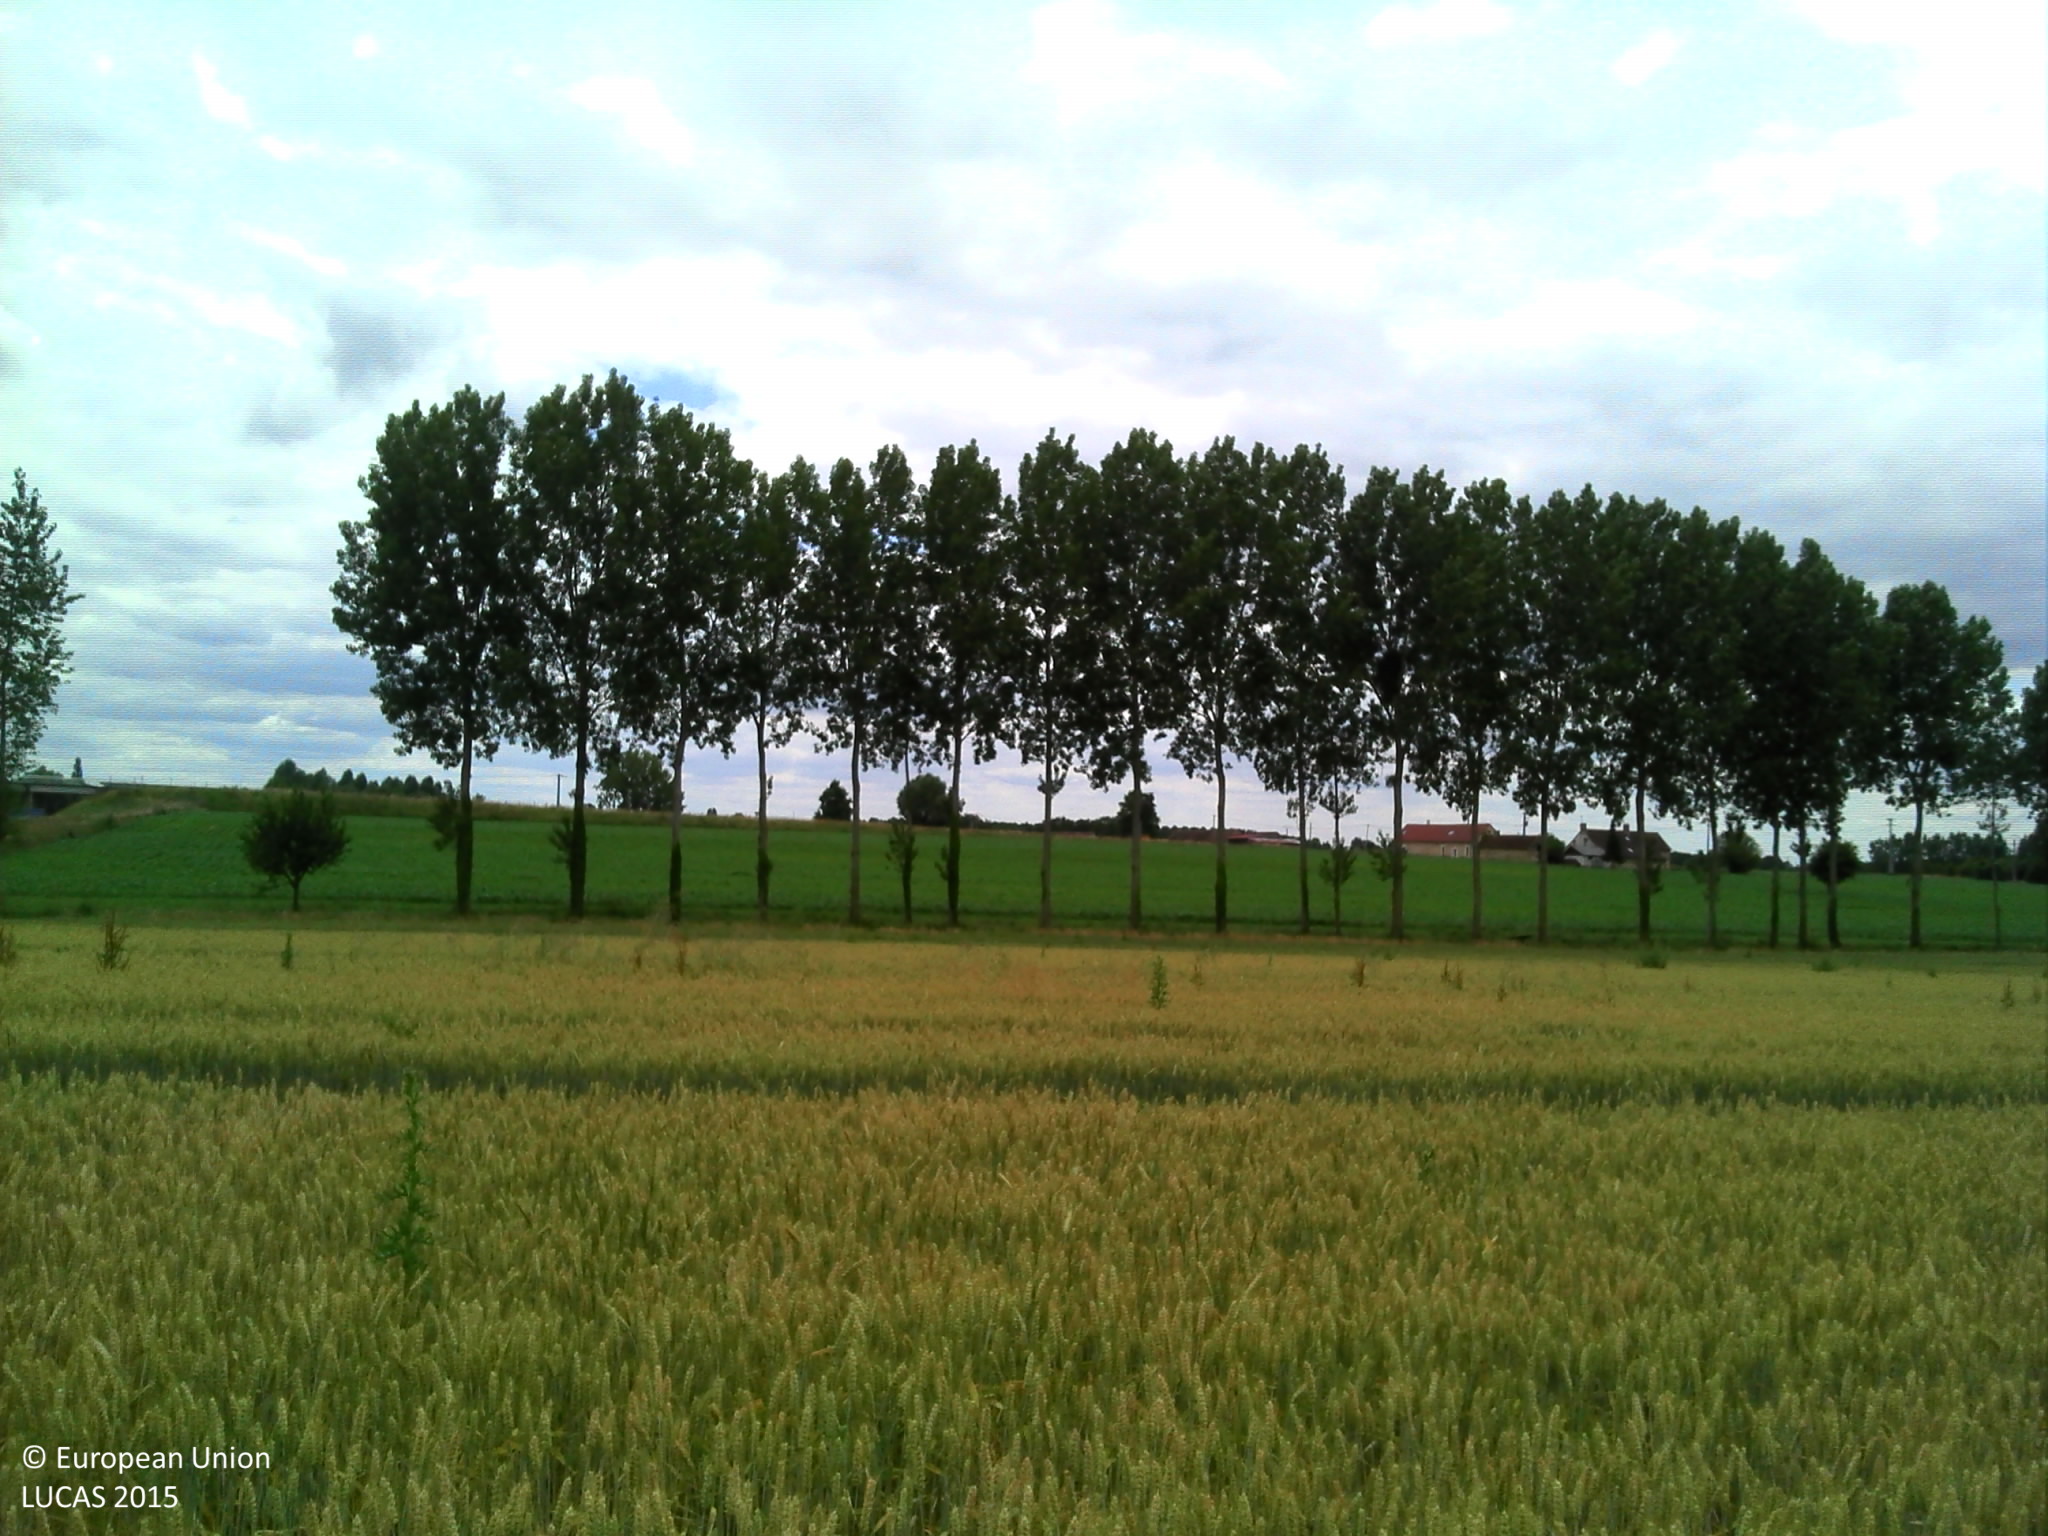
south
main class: Cropland
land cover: Common wheat
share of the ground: > 75 %
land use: Agriculture (excluding fallow land and kitchen gardens)
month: June
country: FR
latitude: 47.9039
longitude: 0.3031
